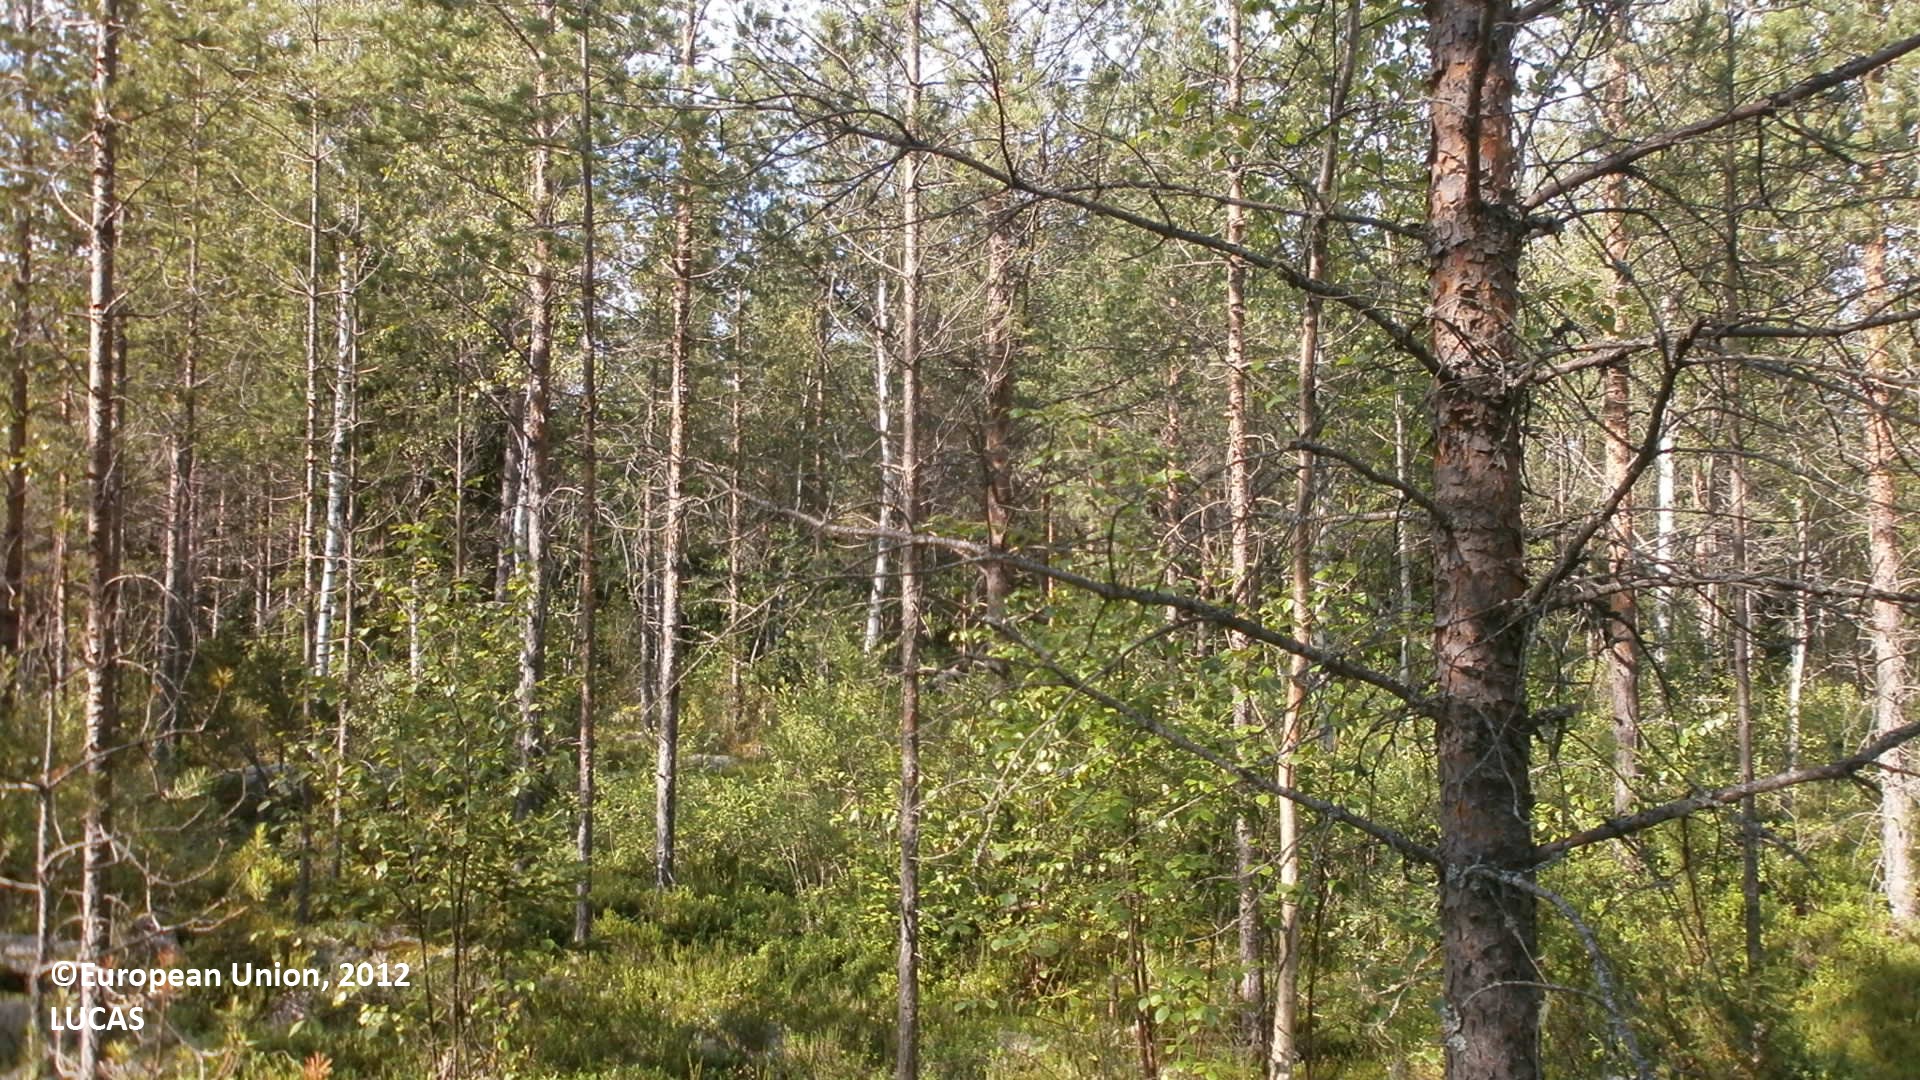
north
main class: Woodland
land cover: Pine dominated coniferous woodland
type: boreal forest
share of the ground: 50 - 75 %
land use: Forestry
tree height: > 5 m
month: July
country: FI
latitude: 64.1814
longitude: 24.3729
